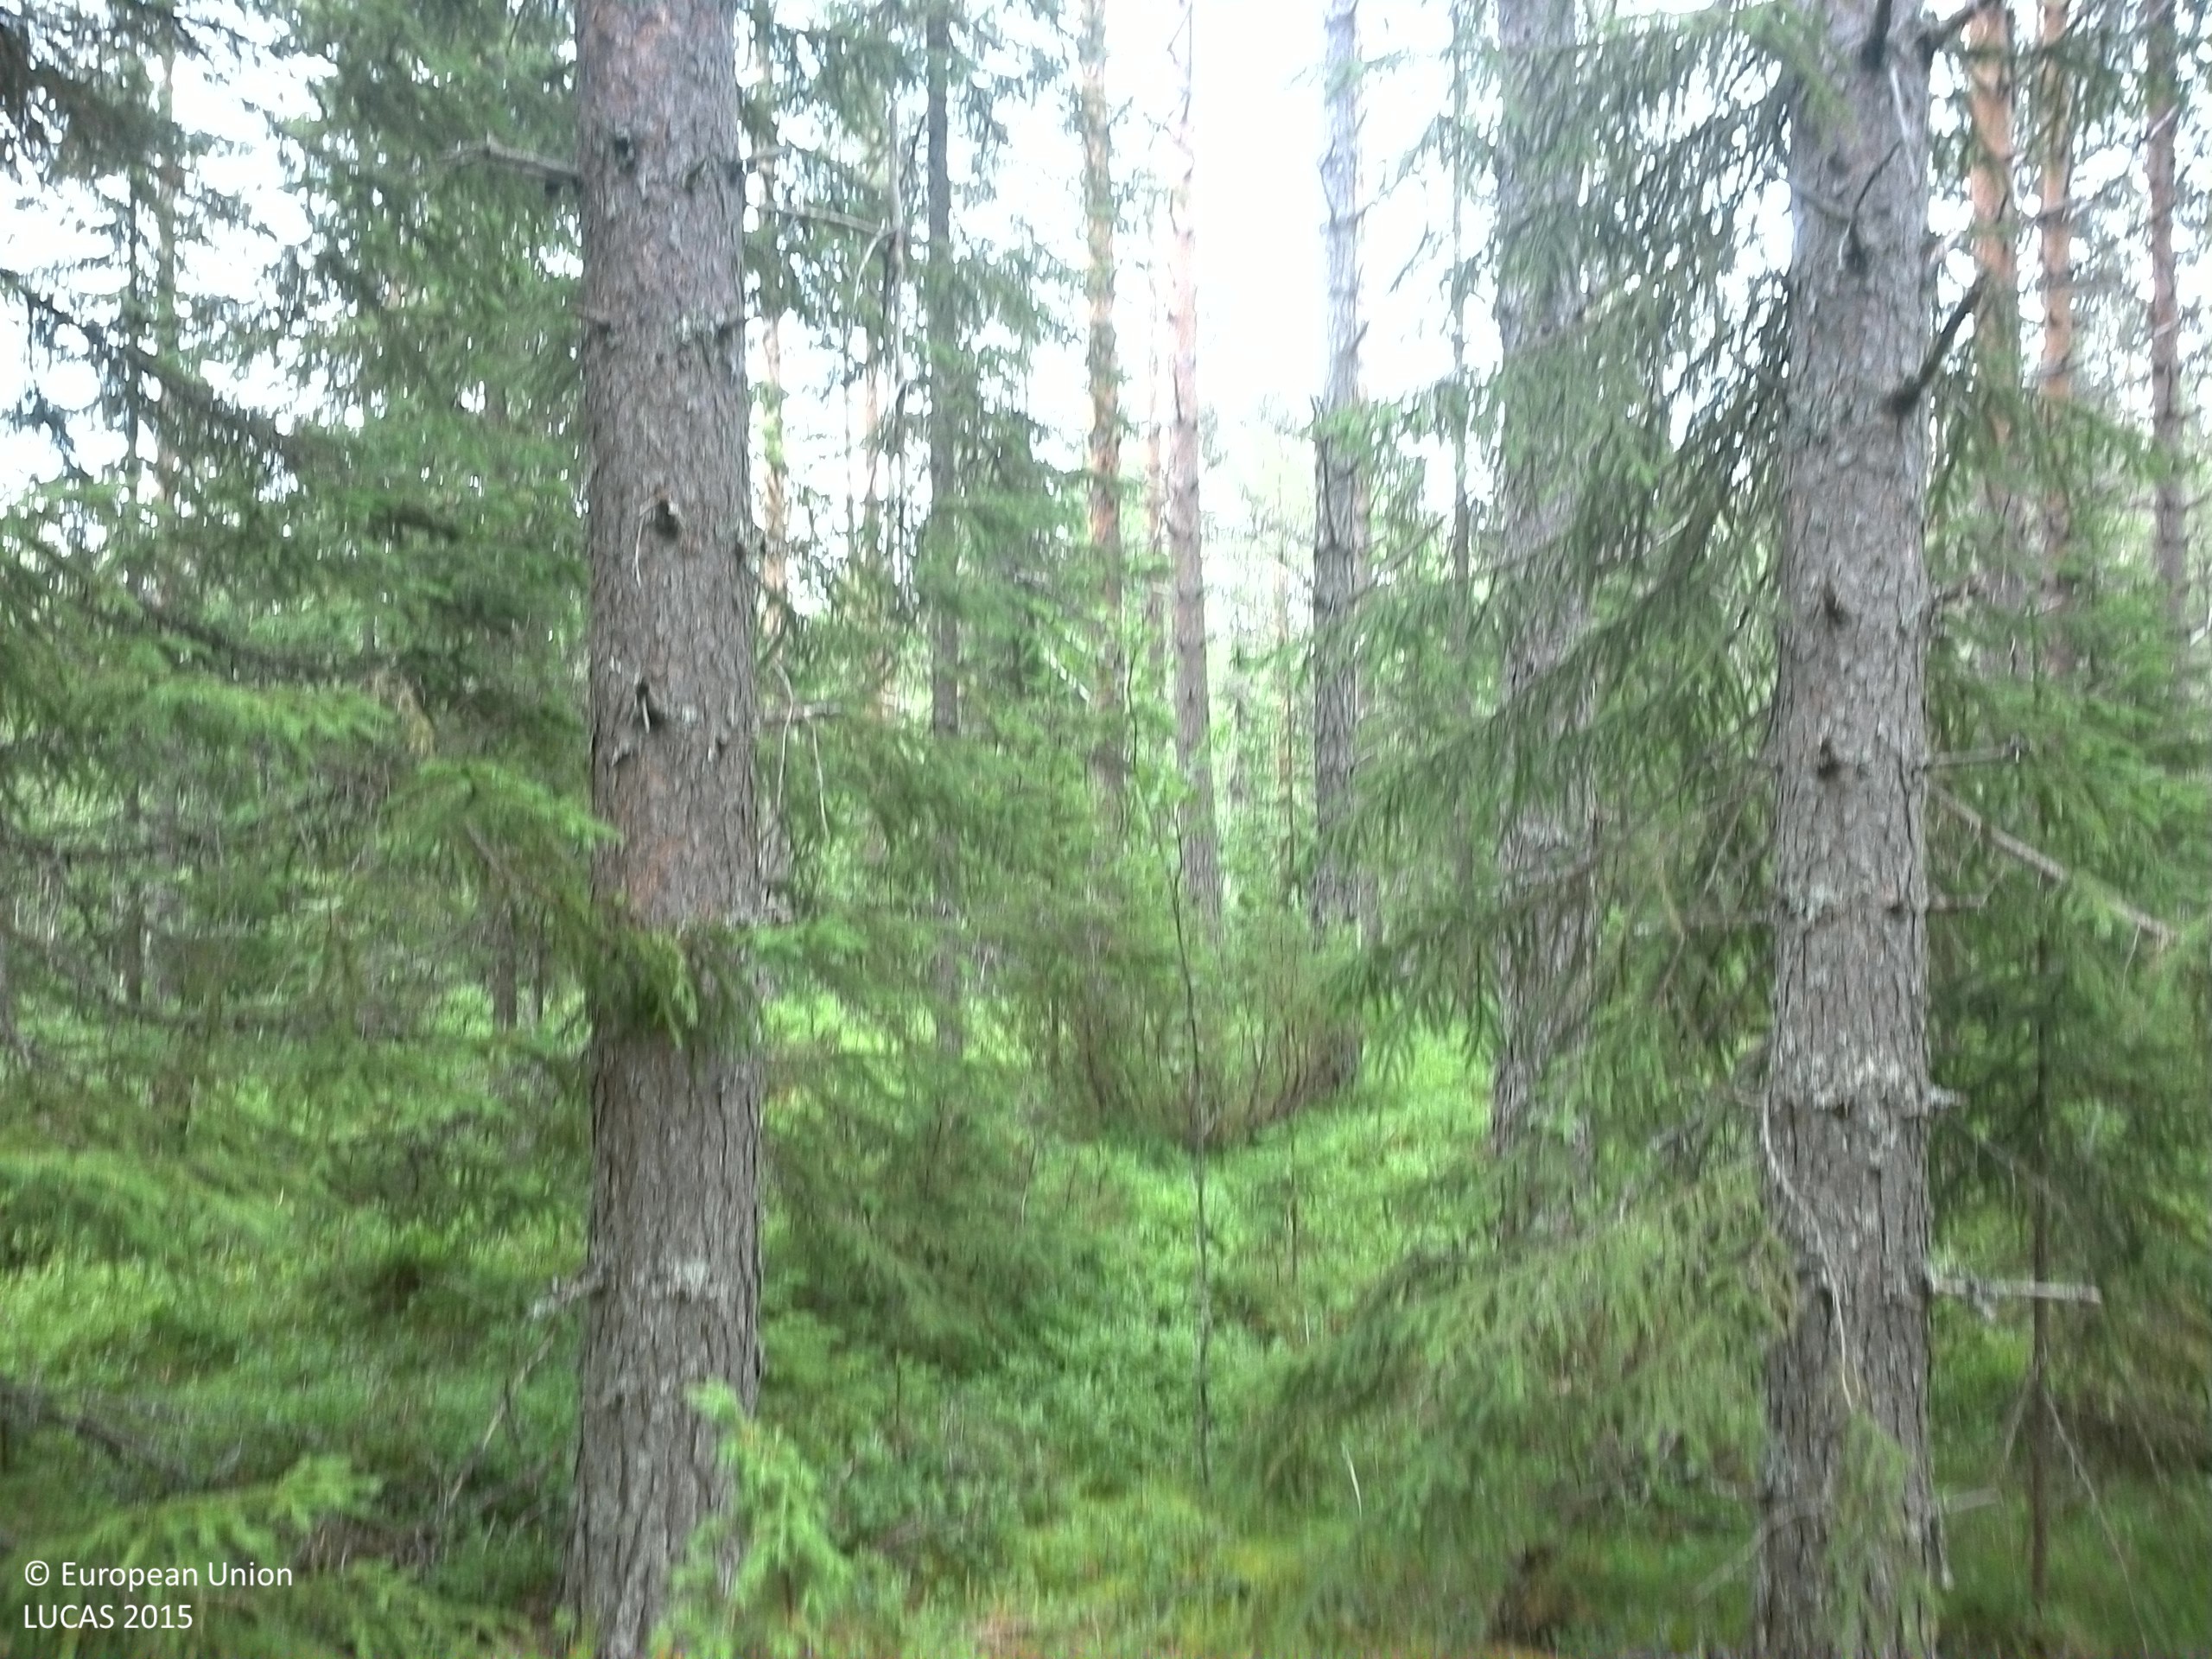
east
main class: Woodland
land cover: Pine dominated coniferous woodland
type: boreal forest
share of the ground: 50 - 75 %
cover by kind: coniferous forest trees 50 %, shrubs 30 %, lichens and mosses 15 %, herbaceous plants 5 %
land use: Forestry
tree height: > 5 m
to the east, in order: Pine dominated coniferous woodland; Pine dominated mixed woodland; Pine dominated coniferous woodland; Rivers and streams; Pine dominated mixed woodland; Pine dominated coniferous woodland; Spruce dominated coniferous woodland; Paved roads, cycling and walking lanes
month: July
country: SE
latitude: 62.7696
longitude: 17.1282
